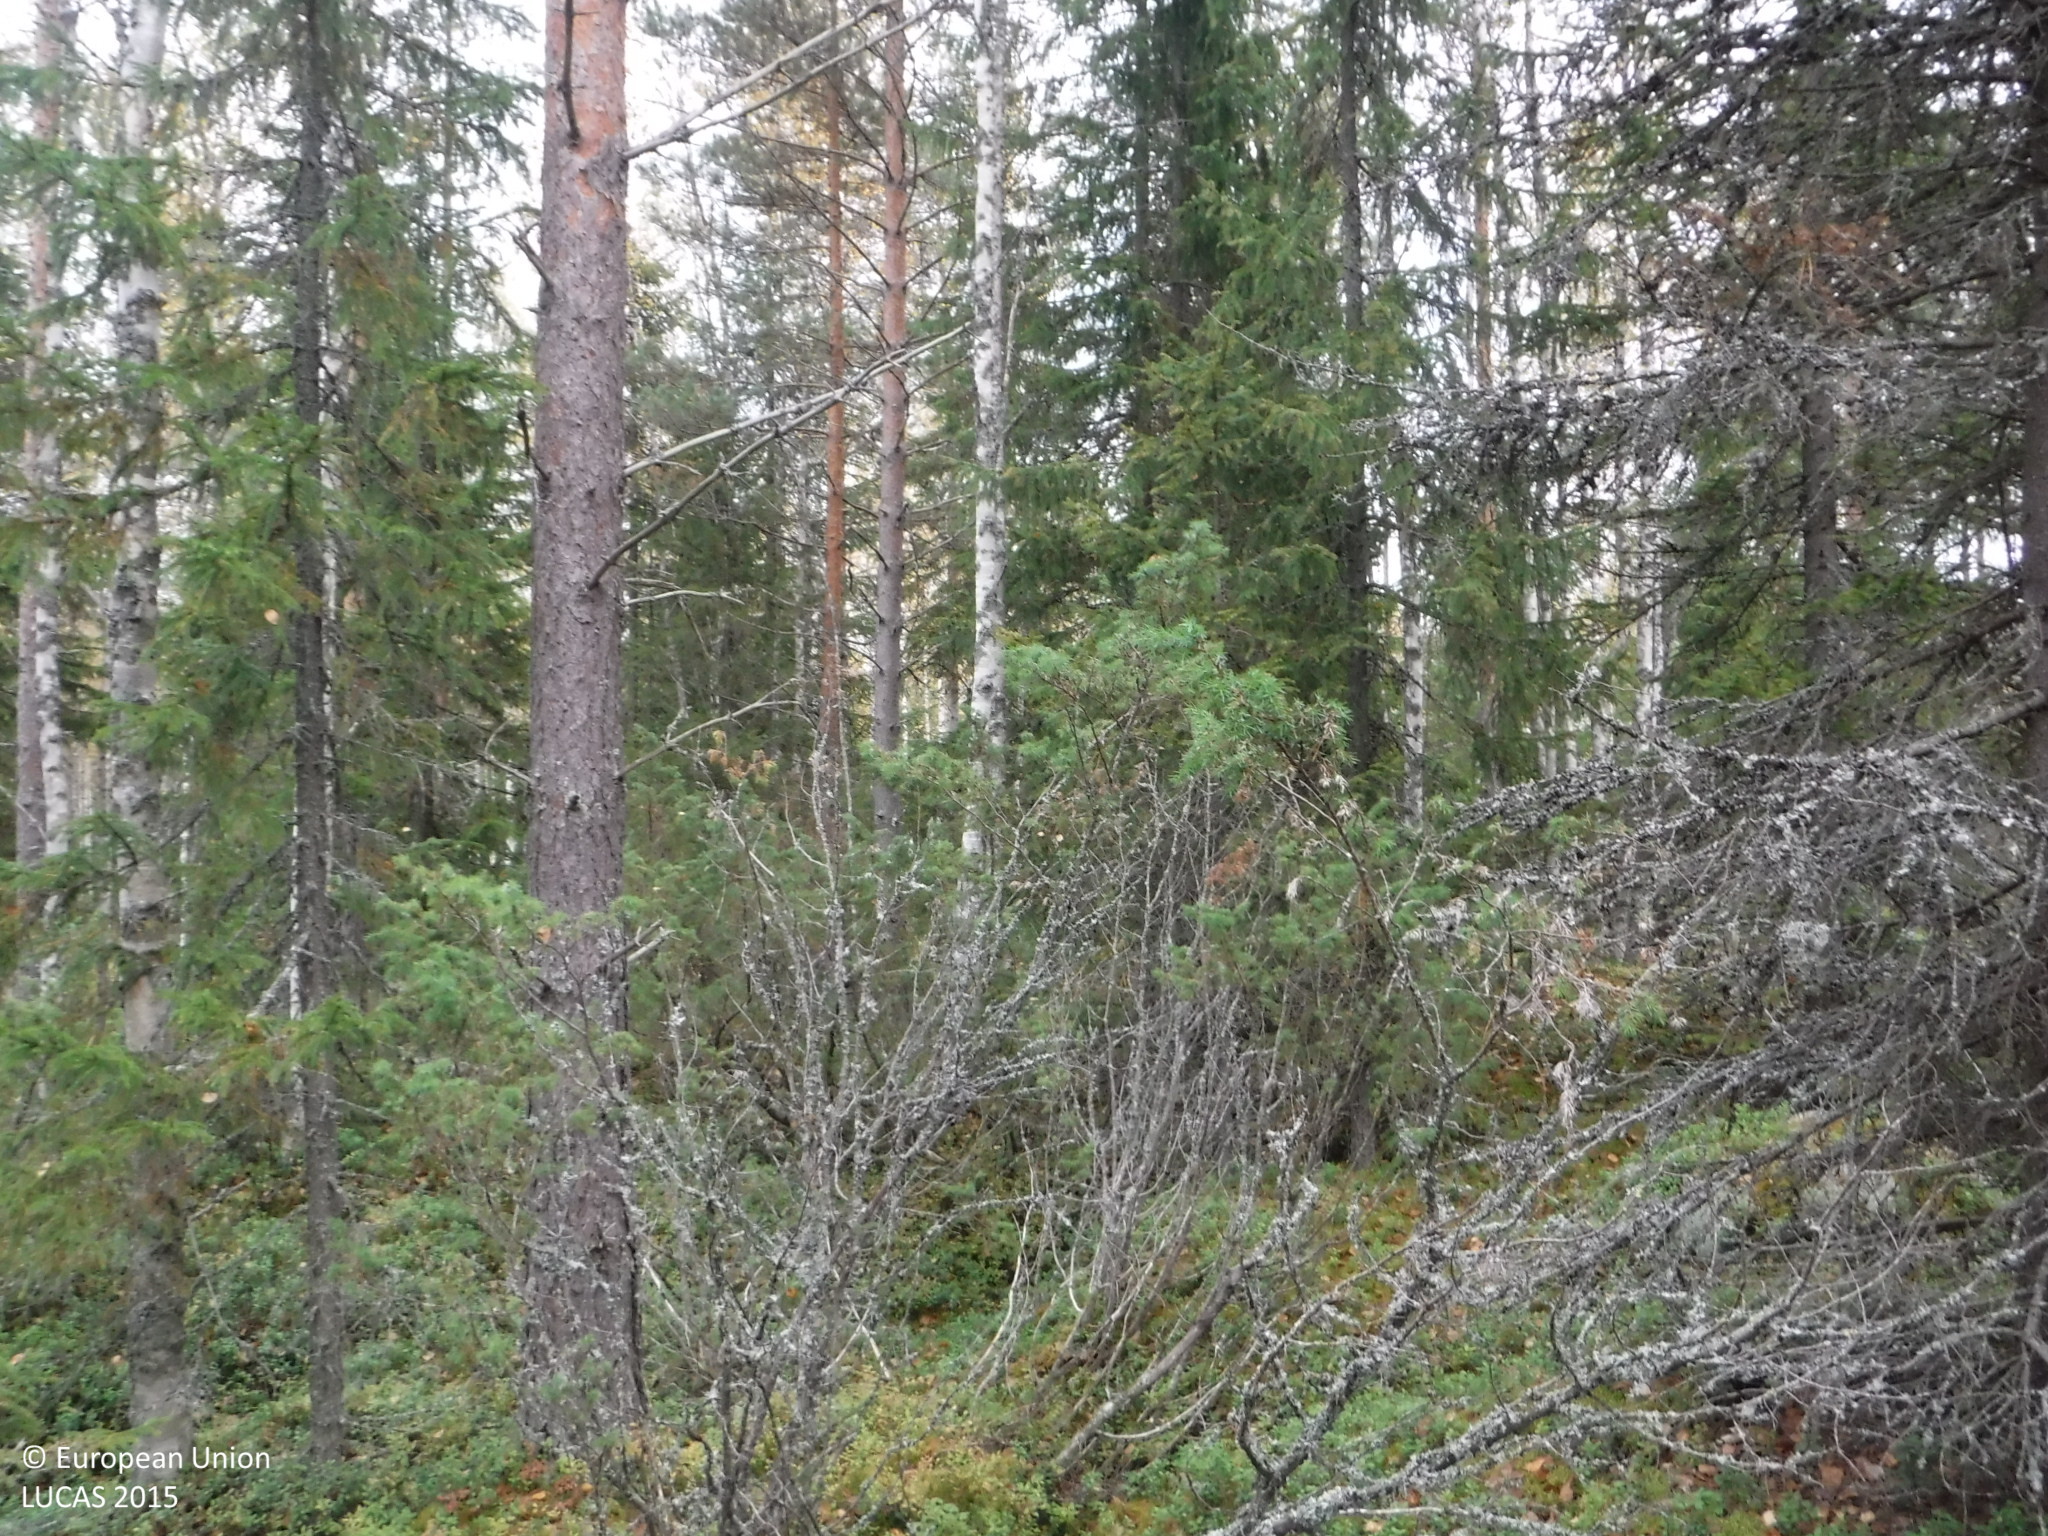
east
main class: Woodland
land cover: Other mixed woodland
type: boreal forest
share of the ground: 50 - 75 %
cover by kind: coniferous forest trees 25 %, broadleaved forest trees 25 %, shrubs 25 %, lichens and mosses 25 %
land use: Forestry
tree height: > 5 m
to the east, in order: Other mixed woodland; Spruce dominated mixed woodland; Pine dominated coniferous woodland; Other coniferous woodland; Other mixed woodland; Other coniferous woodland; Spruce dominated mixed woodland
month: September
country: FI
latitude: 62.0356
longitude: 23.3194
